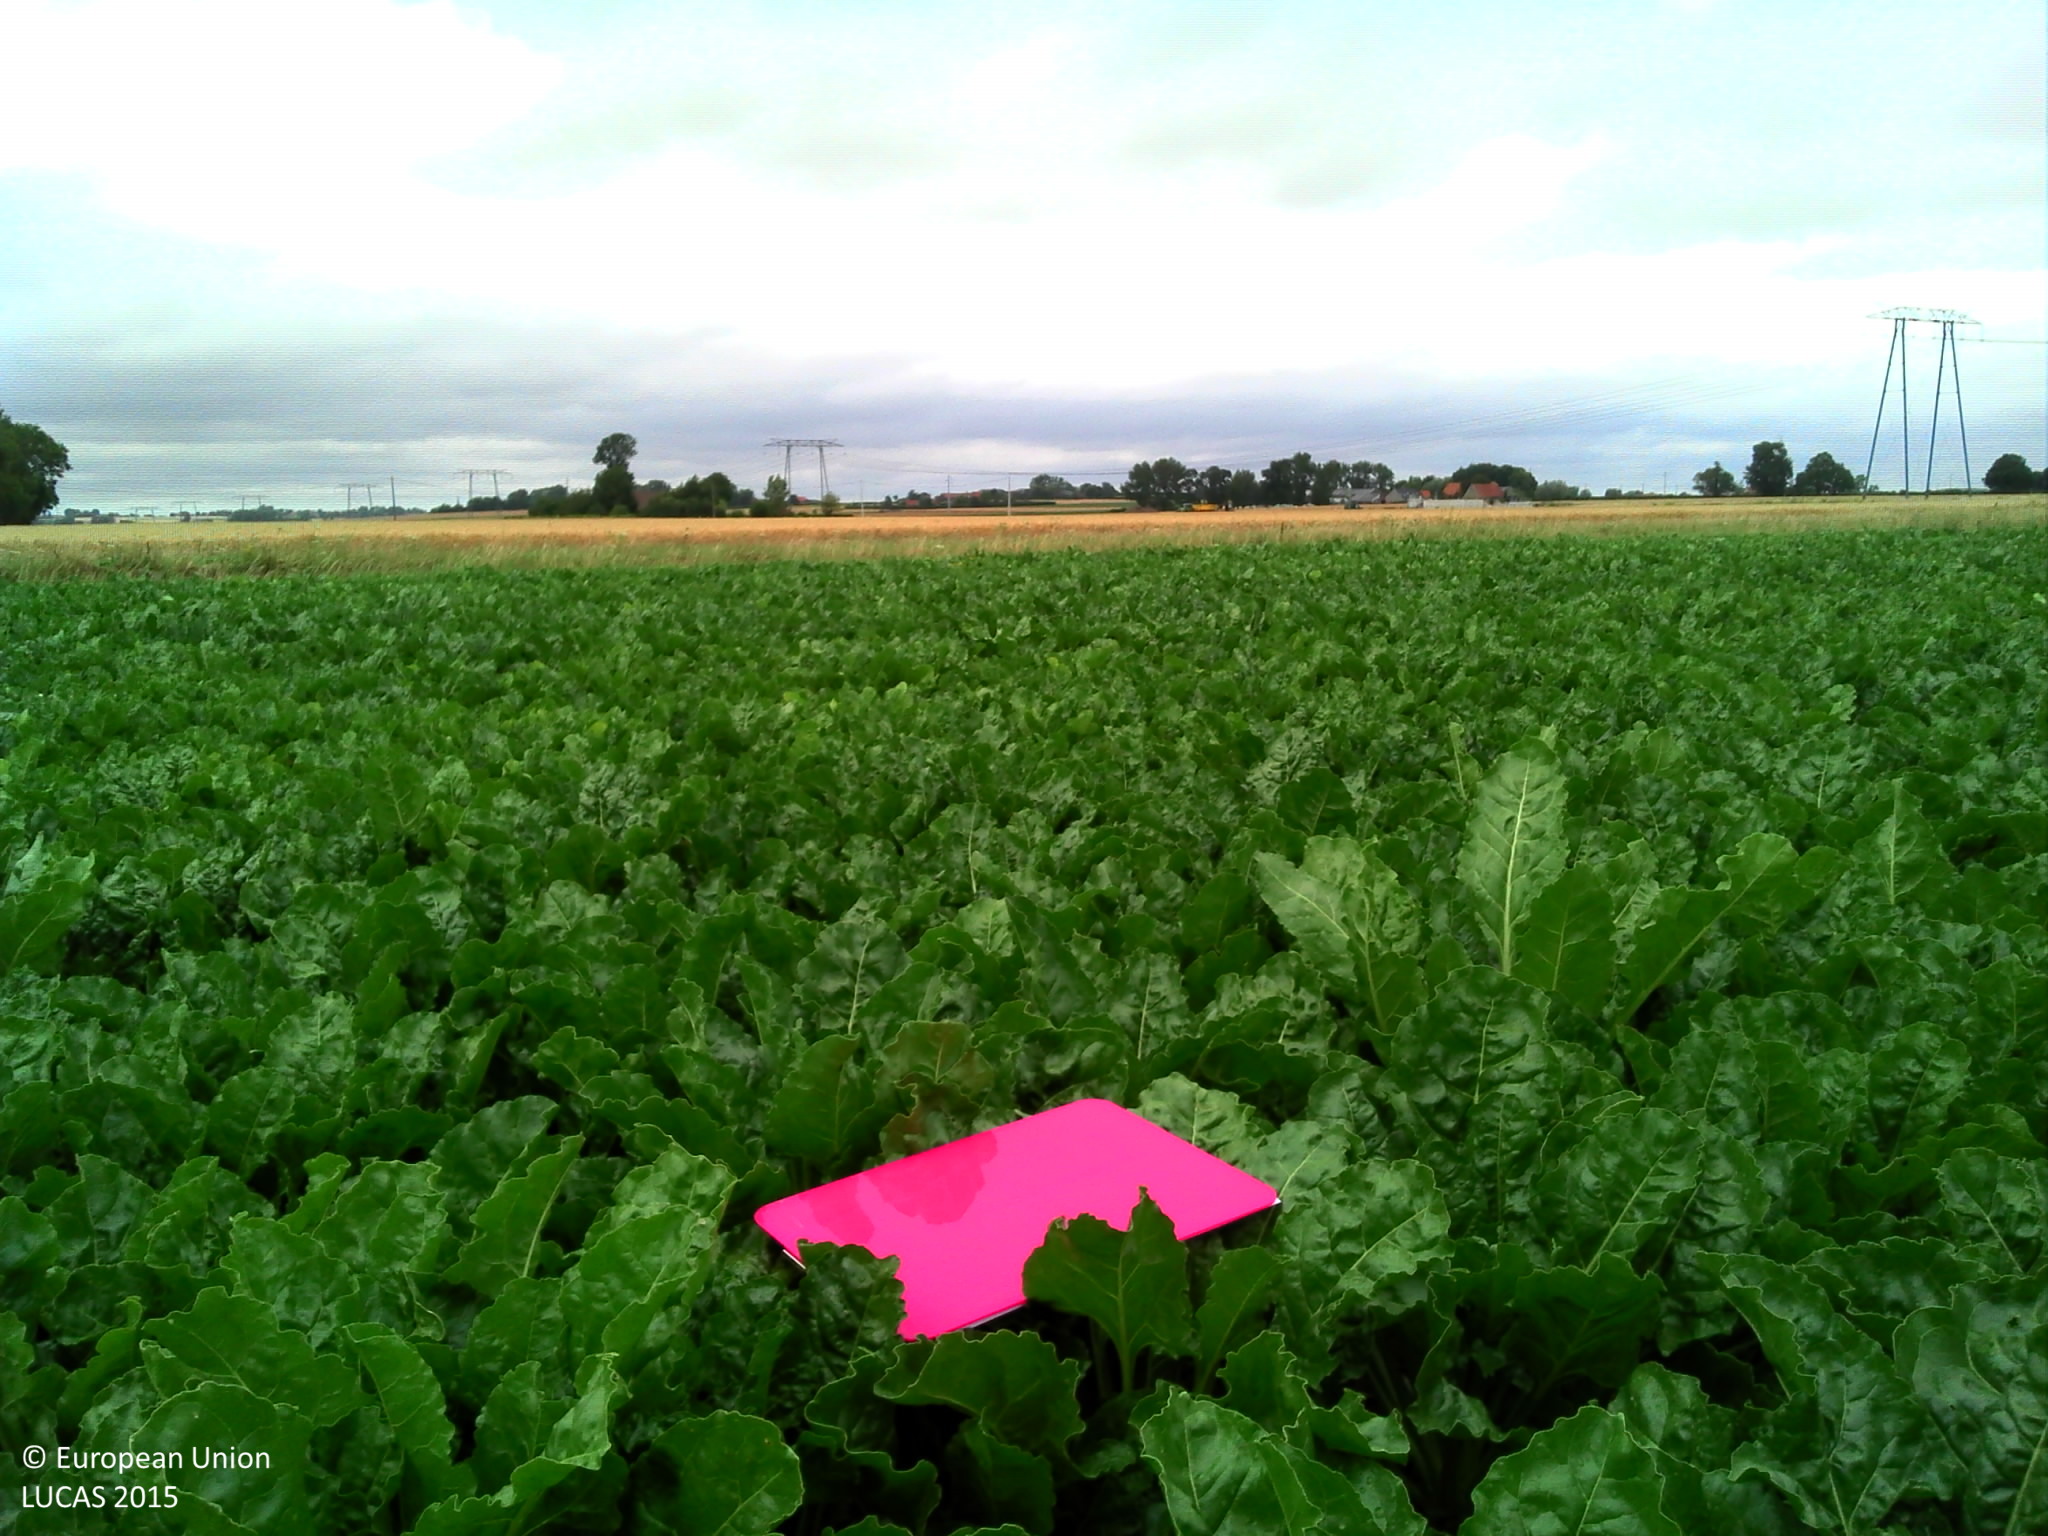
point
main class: Cropland
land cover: Sugar beet
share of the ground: > 75 %
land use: Agriculture (excluding fallow land and kitchen gardens)
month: July
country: FR
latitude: 50.8291
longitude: 2.3338
